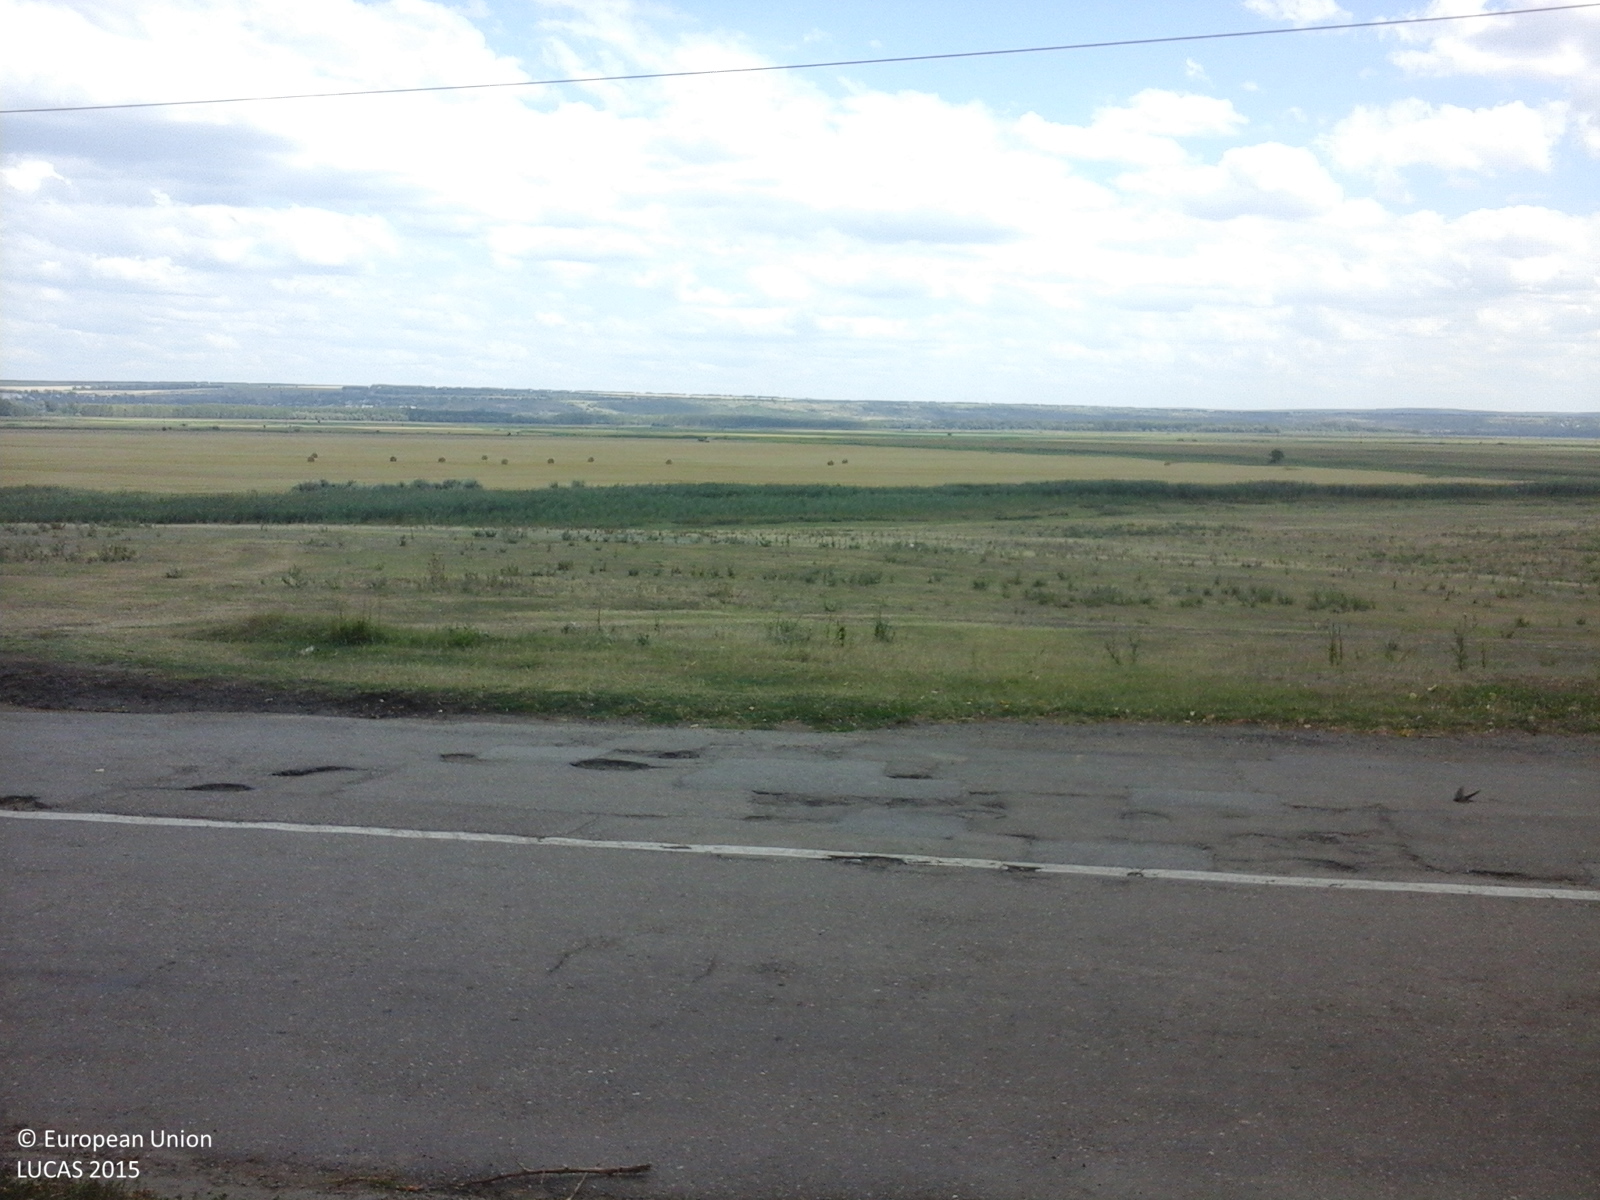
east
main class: Grassland
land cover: Grassland without tree/shrub cover
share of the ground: > 75 %
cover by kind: herbaceous plants 100 %
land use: Residential
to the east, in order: Grassland without tree/shrub cover; Tracks; Lines of trees; Electric lines; Grassland without tree/shrub cover; Inland marshes; Grassland without tree/shrub cover
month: July
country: RO
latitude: 46.4704
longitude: 28.1957
